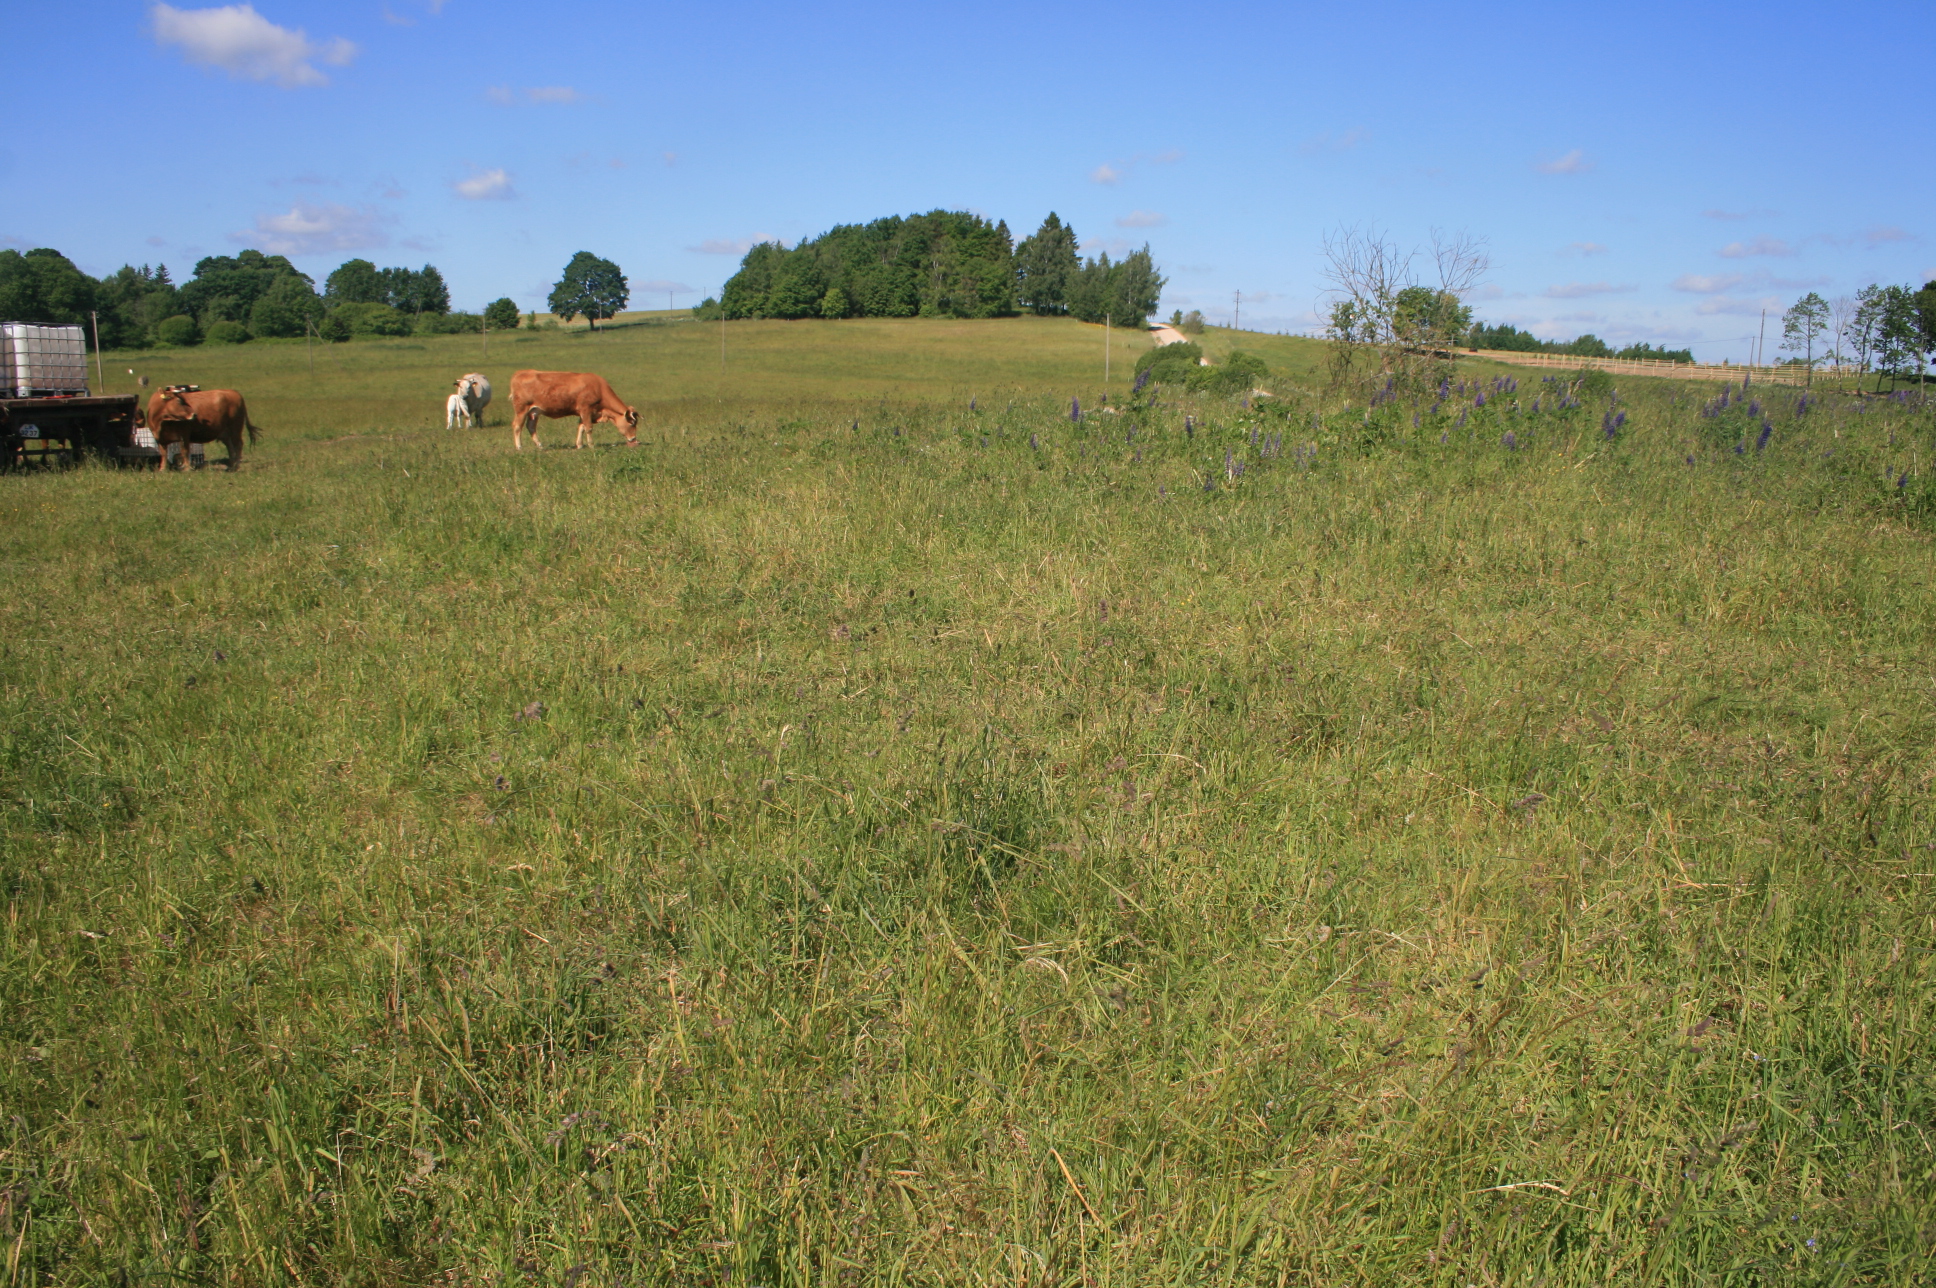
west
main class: Grassland
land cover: Grassland without tree/shrub cover
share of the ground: > 75 %
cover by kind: herbaceous plants 100 %
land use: Agriculture (excluding fallow land and kitchen gardens)
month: June
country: LT
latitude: 55.9420
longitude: 22.2719
